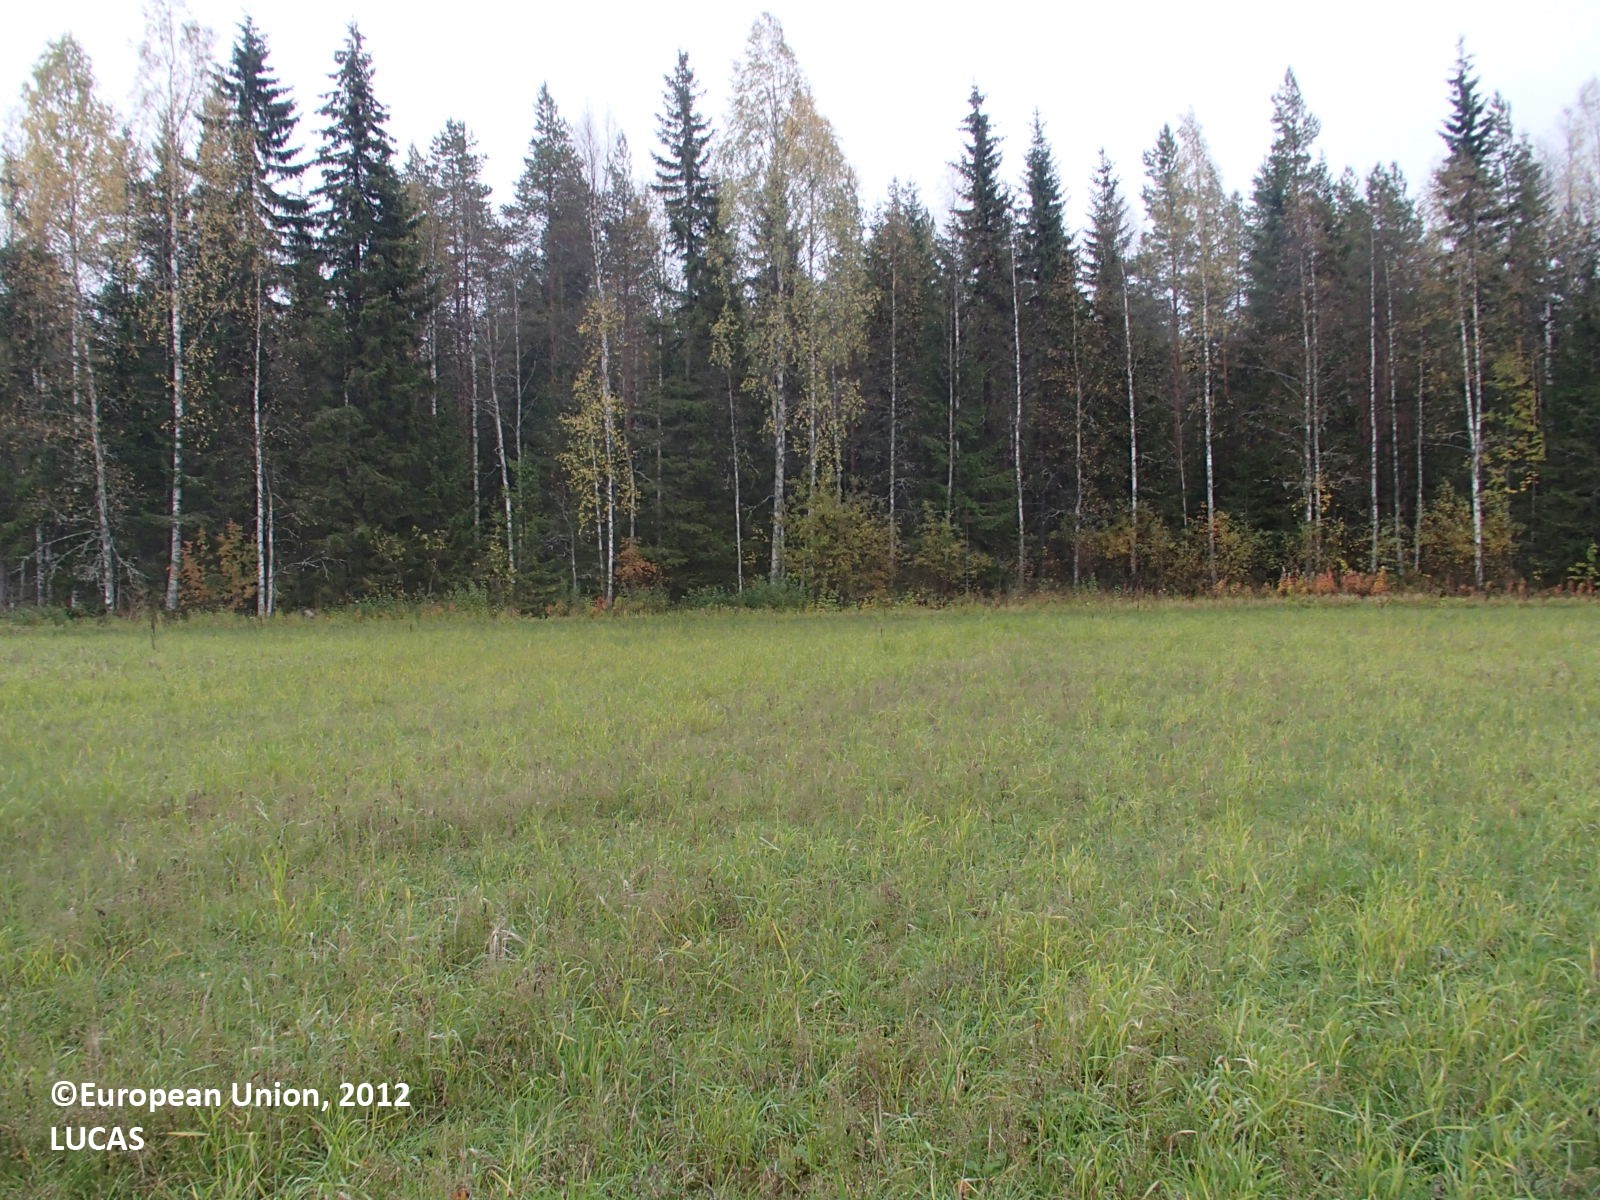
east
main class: Cropland
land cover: Temporary grasslands
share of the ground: > 75 %
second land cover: Barley
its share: < 10 %
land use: Agriculture (excluding fallow land and kitchen gardens)
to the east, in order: Temporary grasslands; Ditches and canals; Abandoned hedges; Spruce dominated mixed woodland; Ditches and canals; Spruce dominated mixed woodland
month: September
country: FI
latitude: 63.7988
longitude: 26.8813
